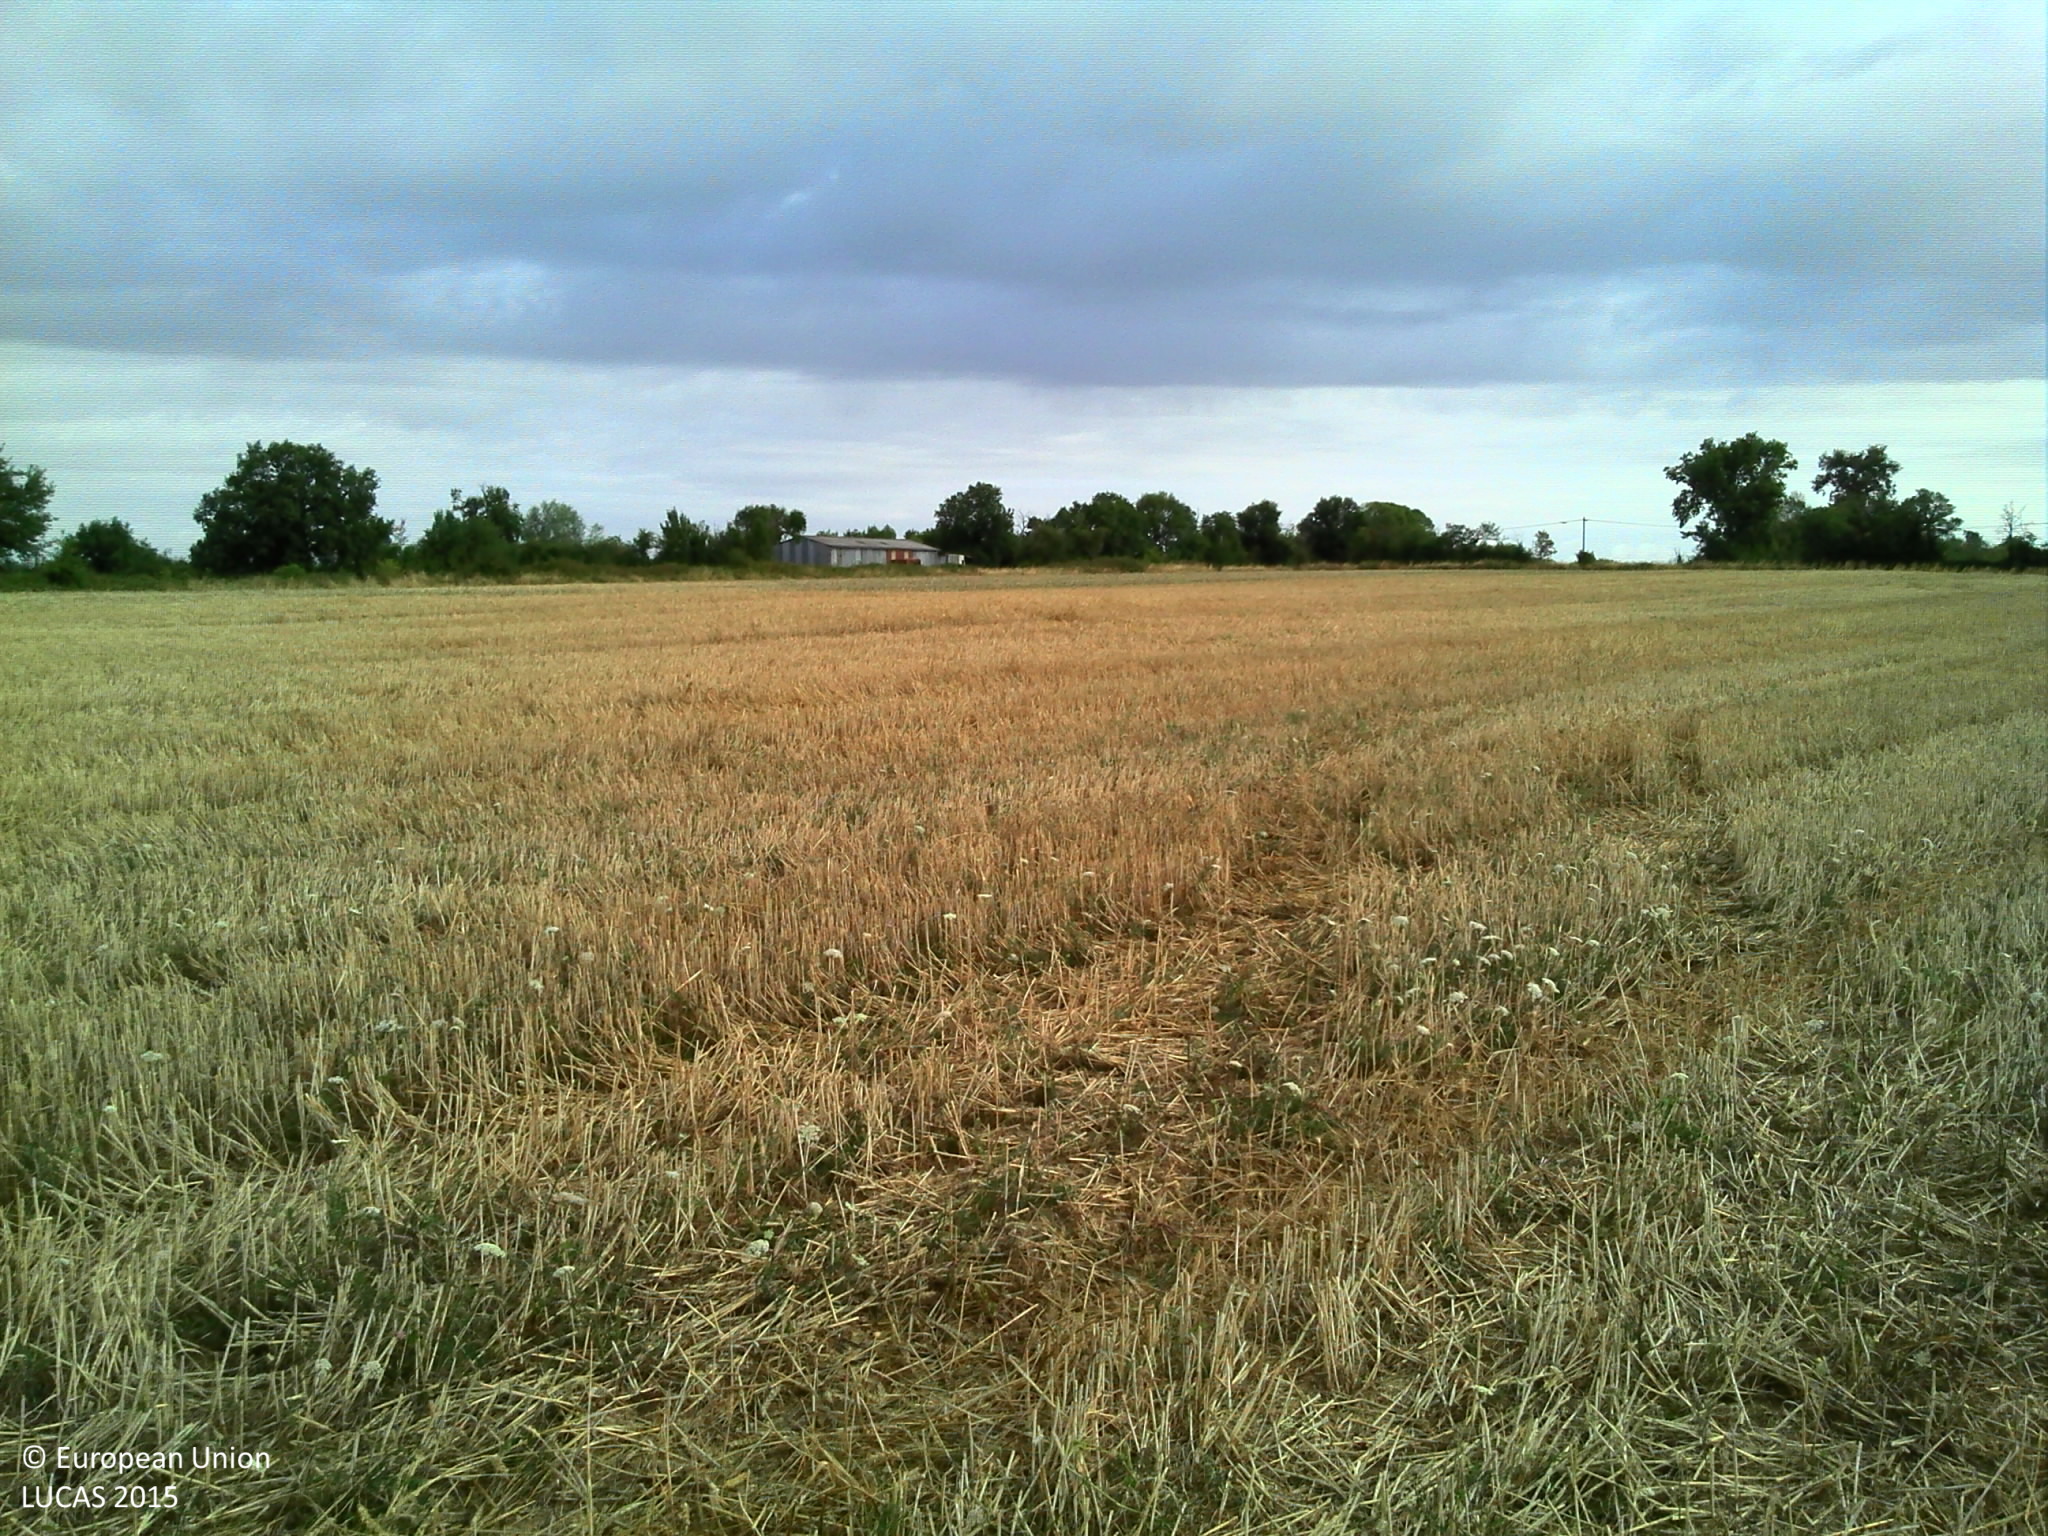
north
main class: Cropland
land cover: Common wheat
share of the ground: 50 - 75 %
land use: Agriculture (excluding fallow land and kitchen gardens)
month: July
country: FR
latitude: 46.3114
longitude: 0.3338
